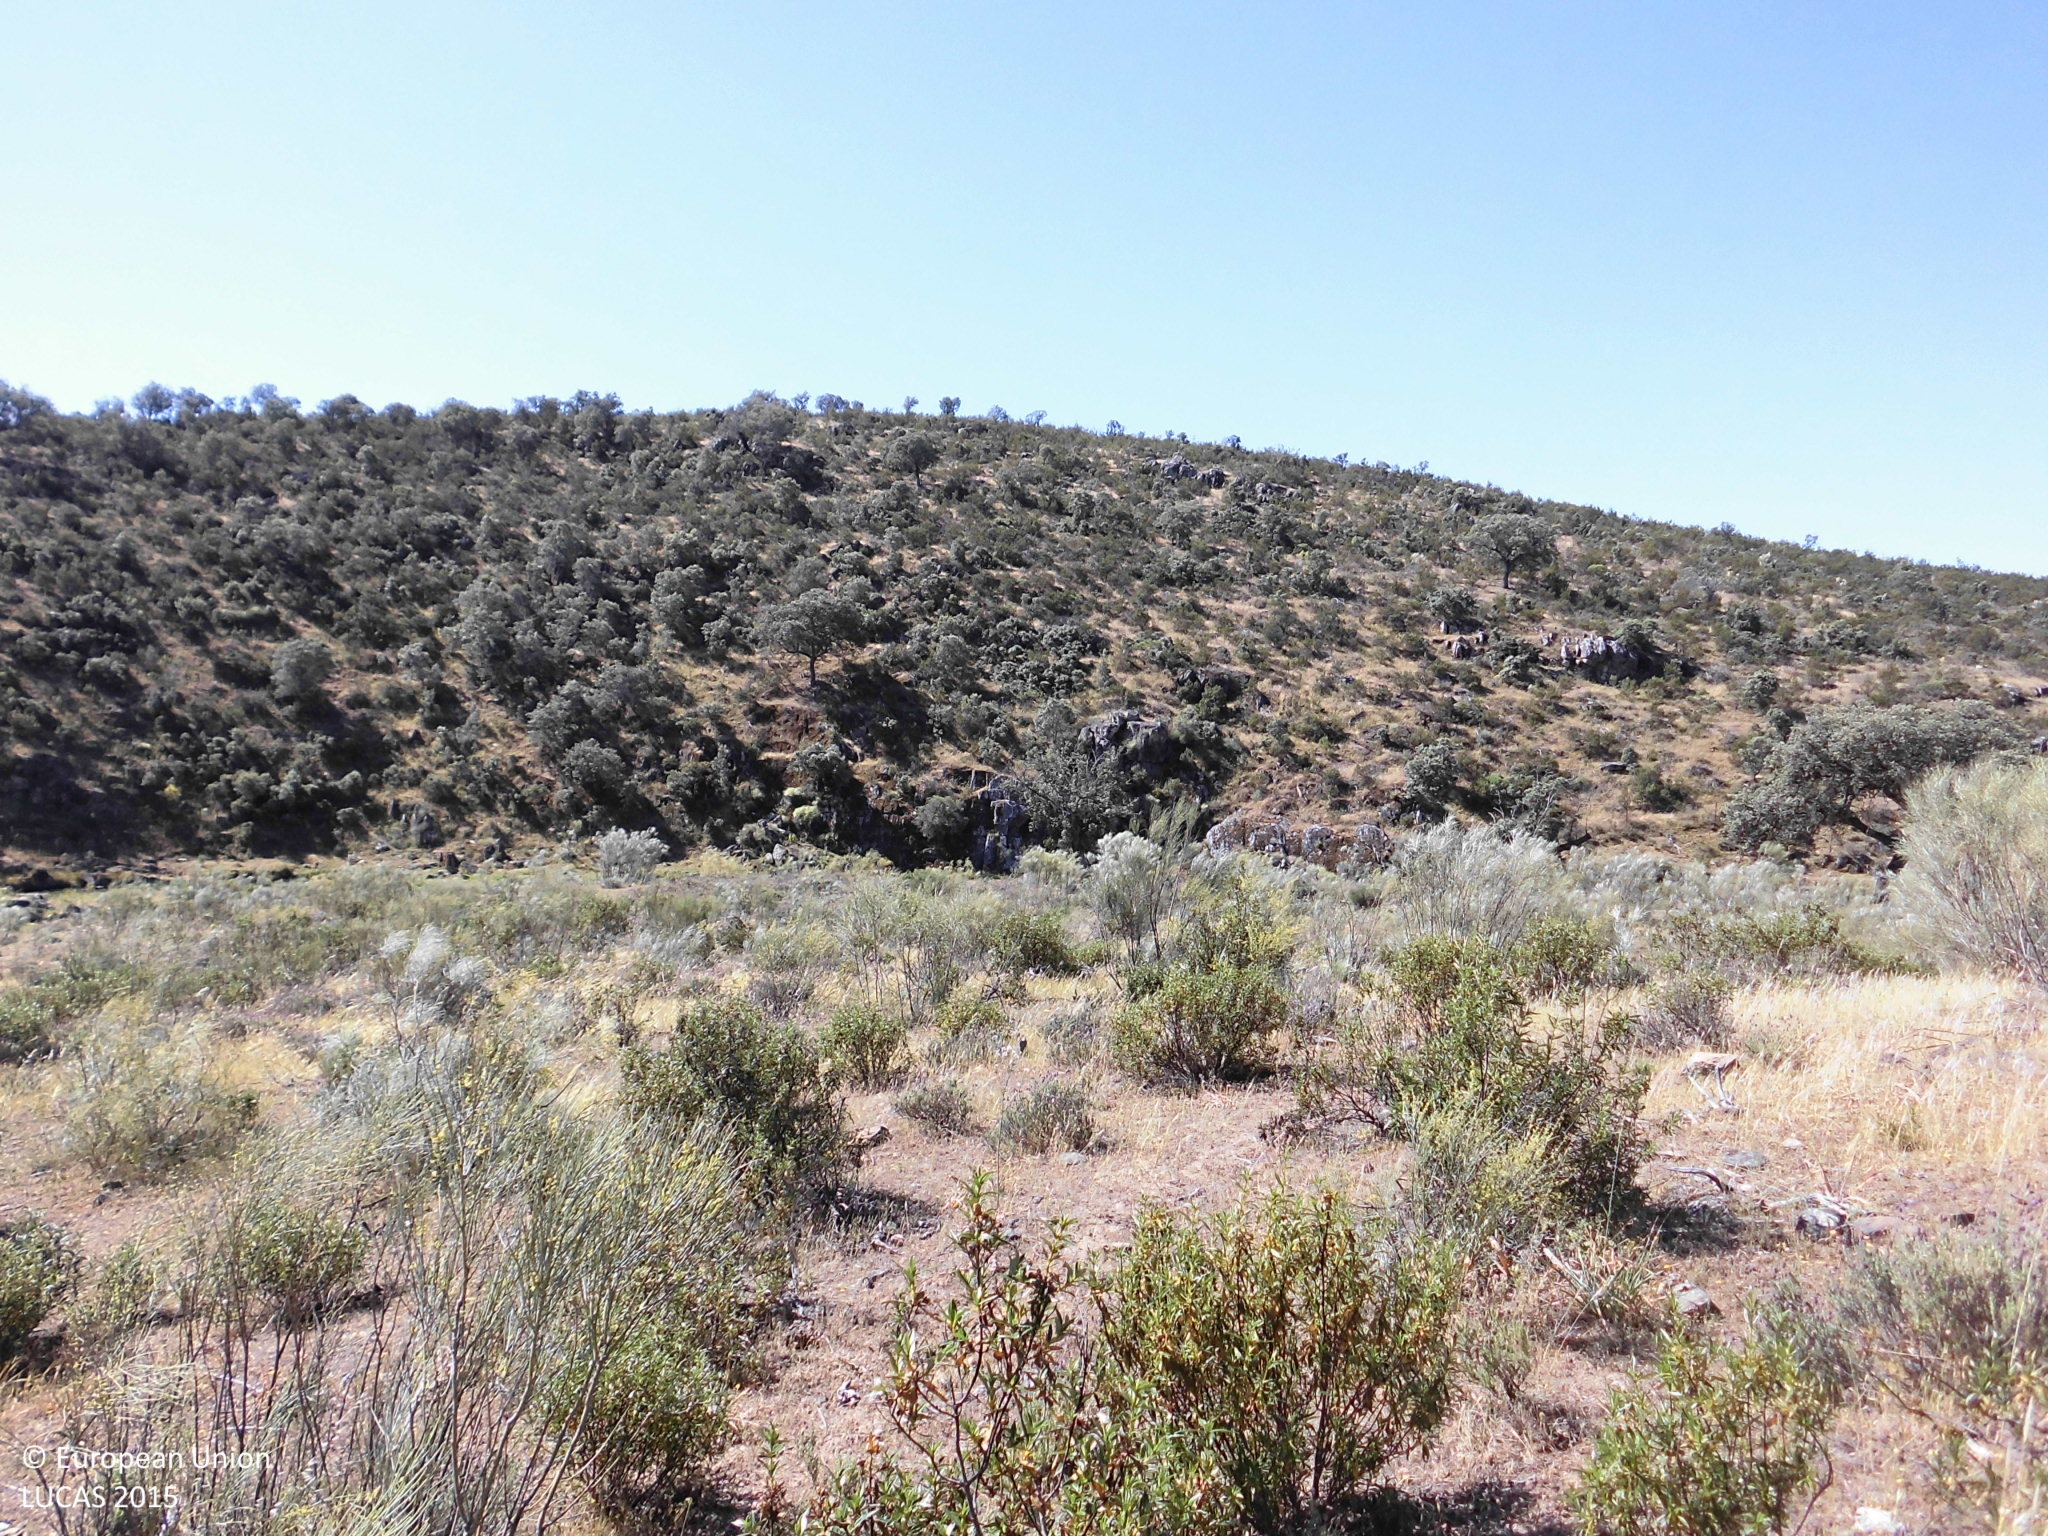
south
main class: Shrubland
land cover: Shrubland without tree cover
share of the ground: 50 - 75 %
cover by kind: shrubs 55 %, herbaceous plants 45 %
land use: Semi-natural and natural areas not in use
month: May
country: ES
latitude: 39.4772
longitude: -6.9720
